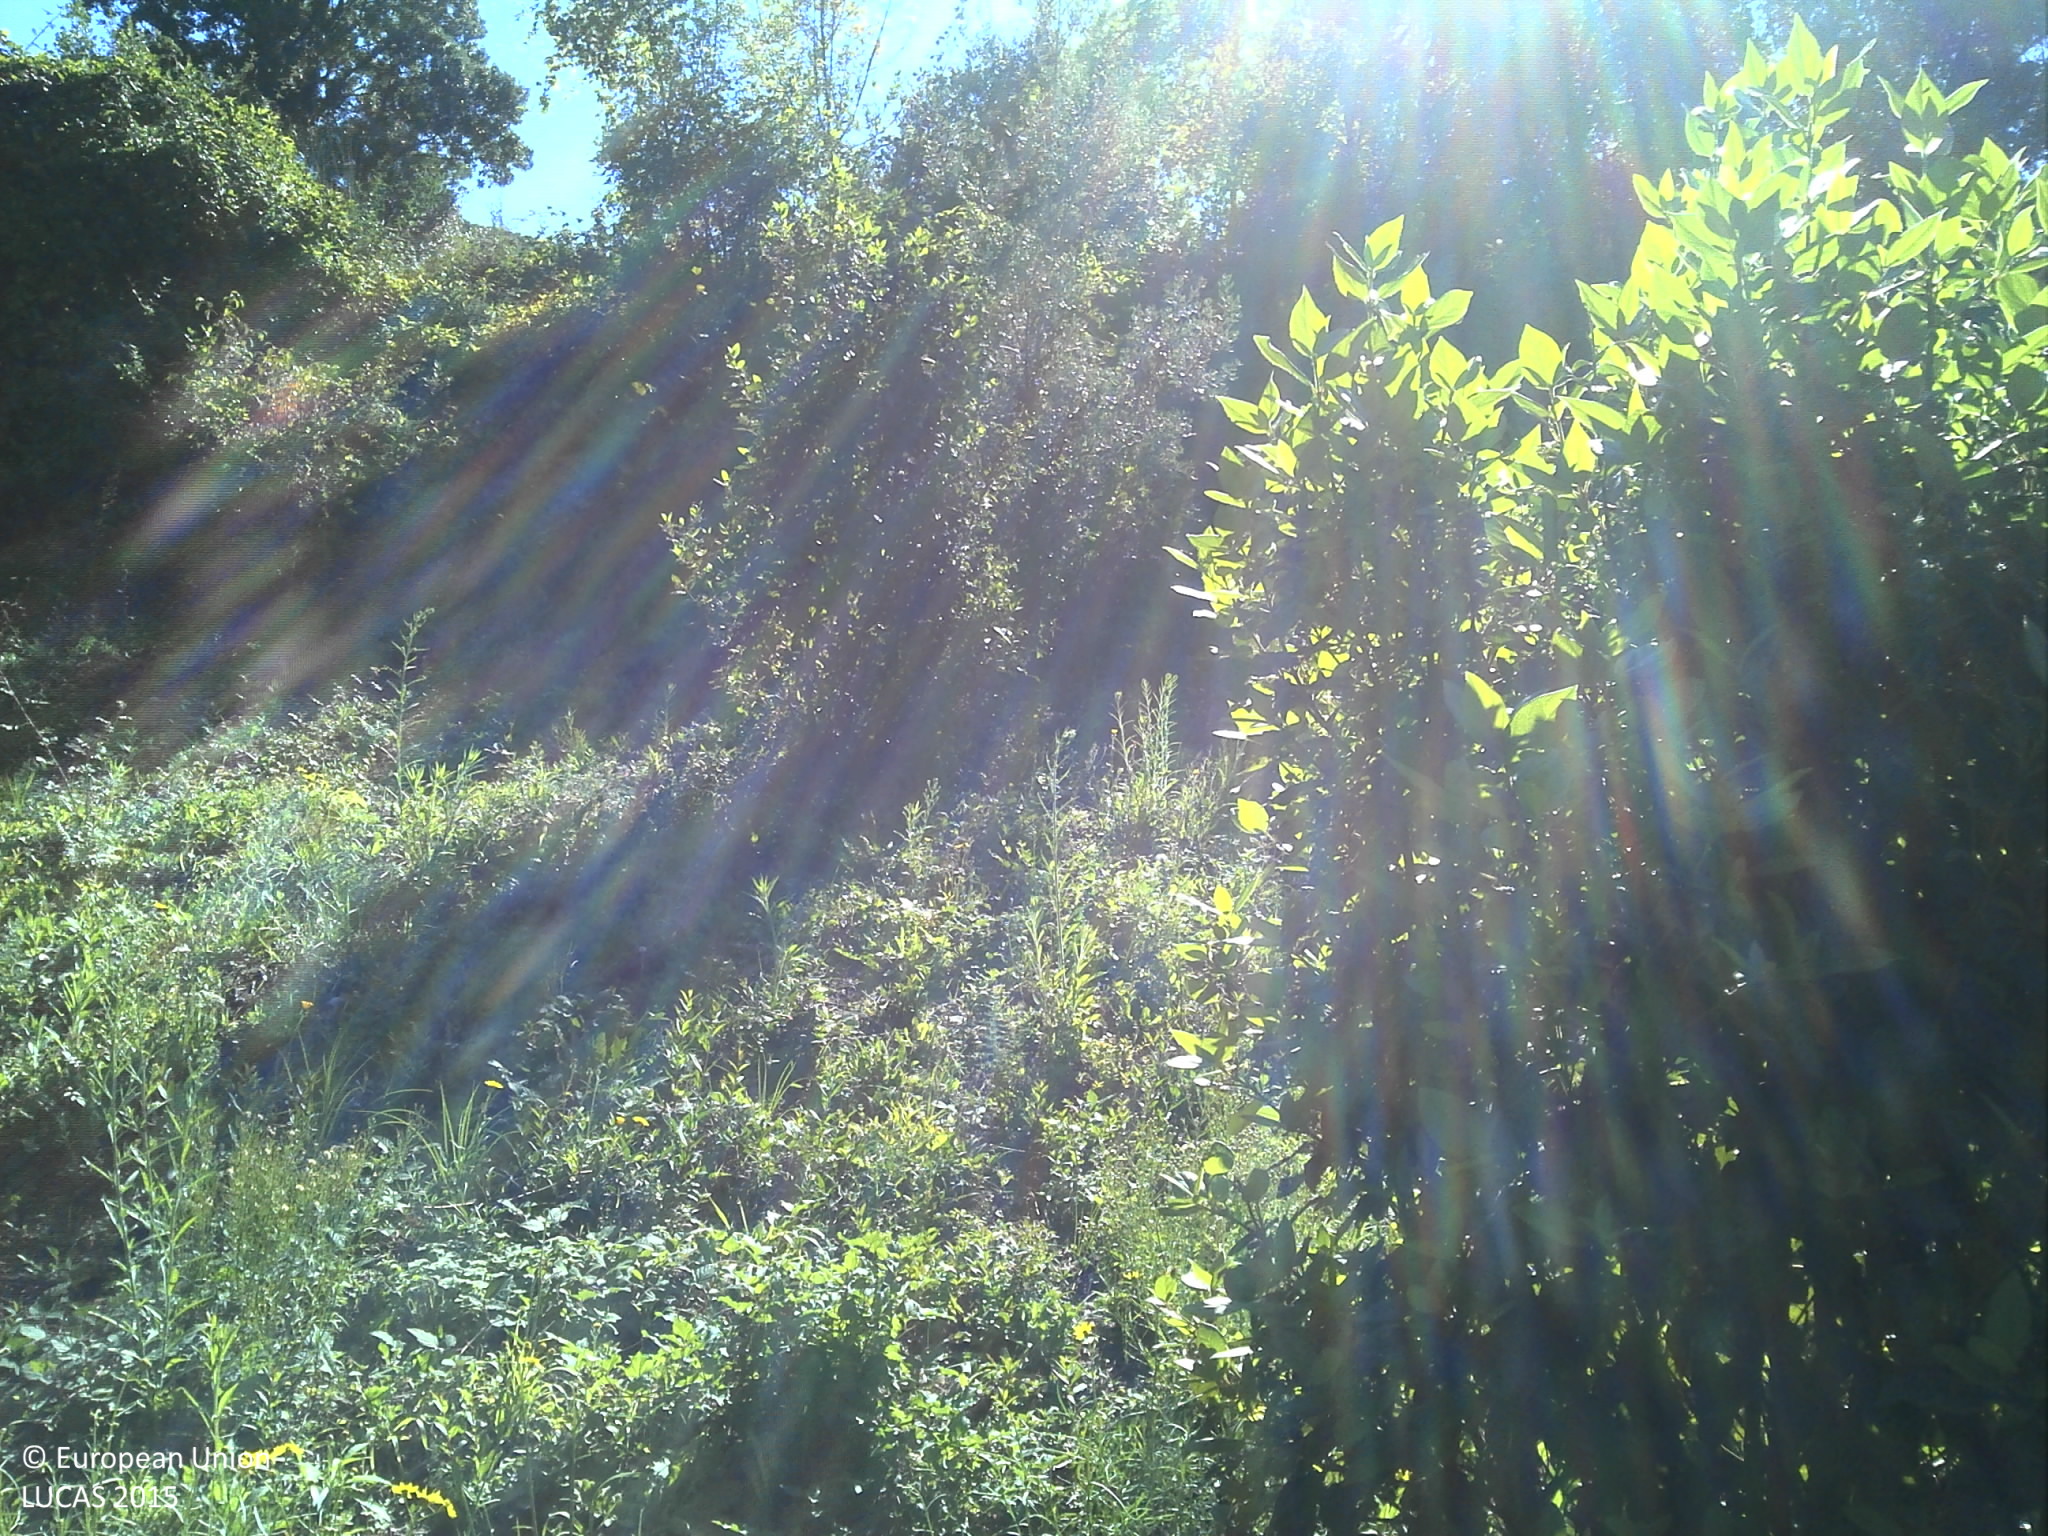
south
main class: Woodland
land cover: Broadleaved woodland
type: mesophytic deciduous forest
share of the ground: 50 - 75 %
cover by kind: broadleaved forest trees 55 %, herbaceous plants 40 %, shrubs 5 %
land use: Forestry
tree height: > 5 m
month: October
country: FR
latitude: 43.5997
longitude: 3.1577
